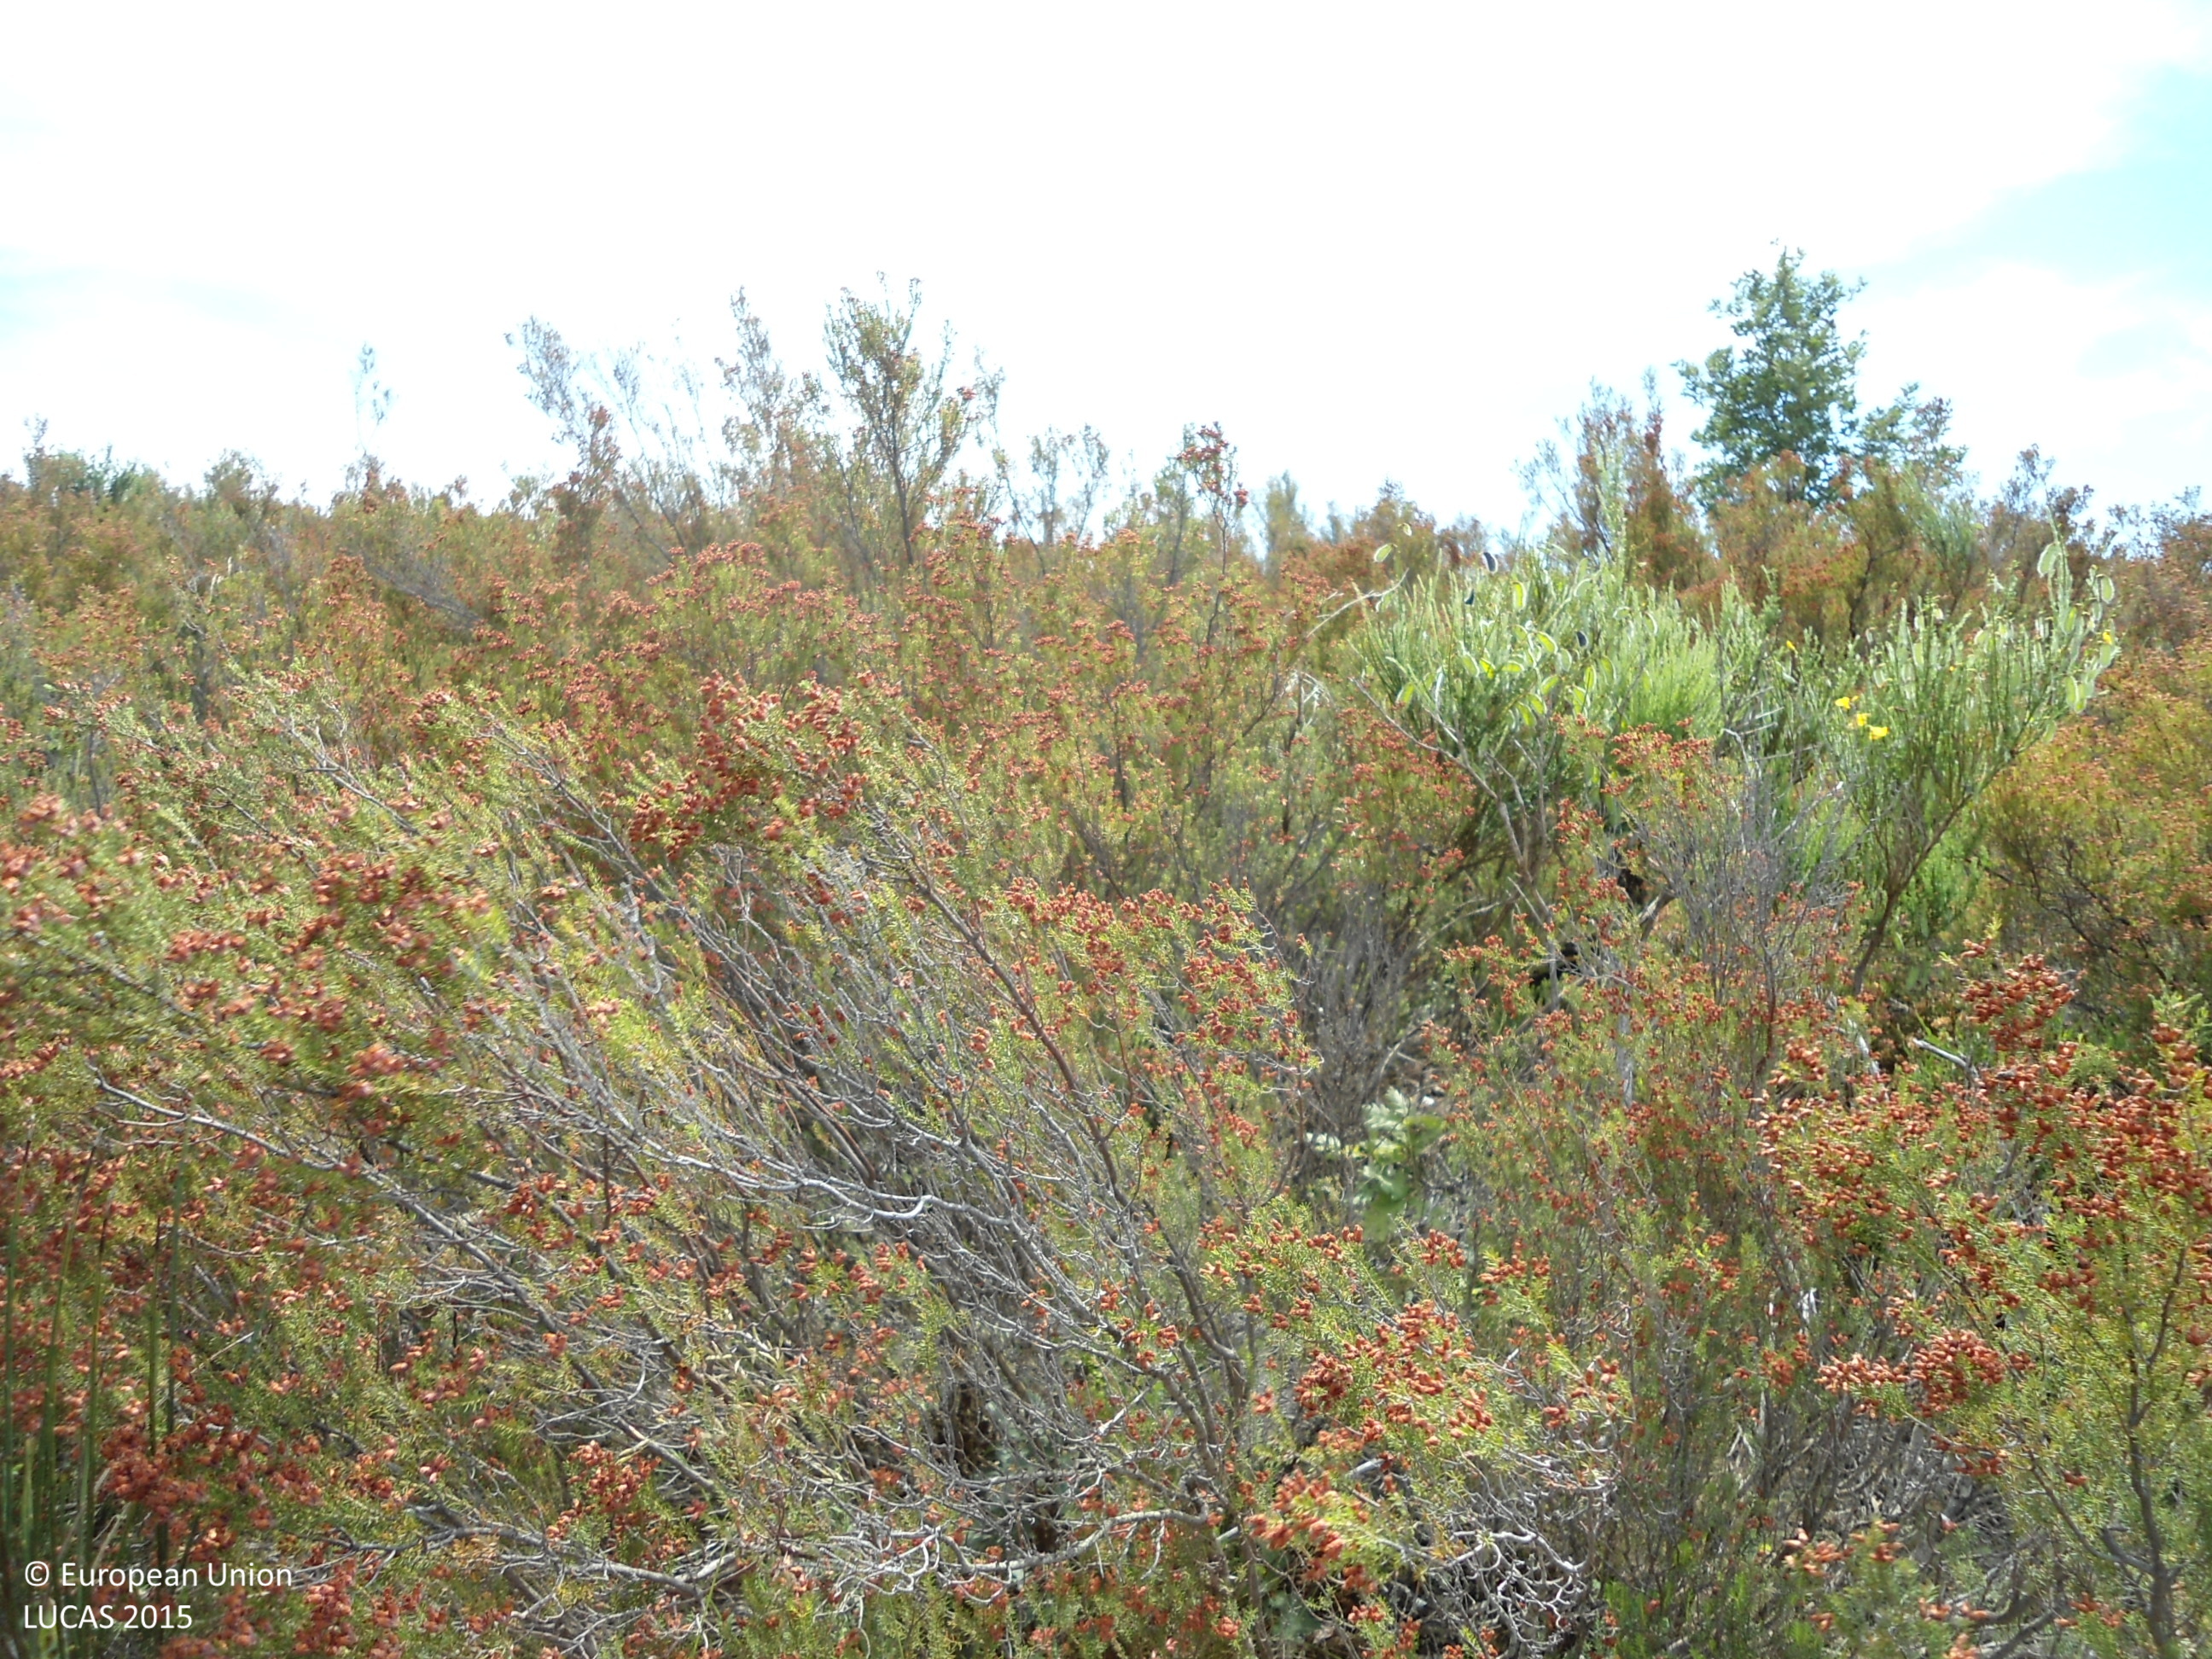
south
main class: Shrubland
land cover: Shrubland with sparse tree cover
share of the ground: > 75 %
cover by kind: shrubs 95 %, broadleaved forest trees 5 %
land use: Semi-natural and natural areas not in use
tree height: < 5 m
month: June
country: ES
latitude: 42.1193
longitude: -6.5999
